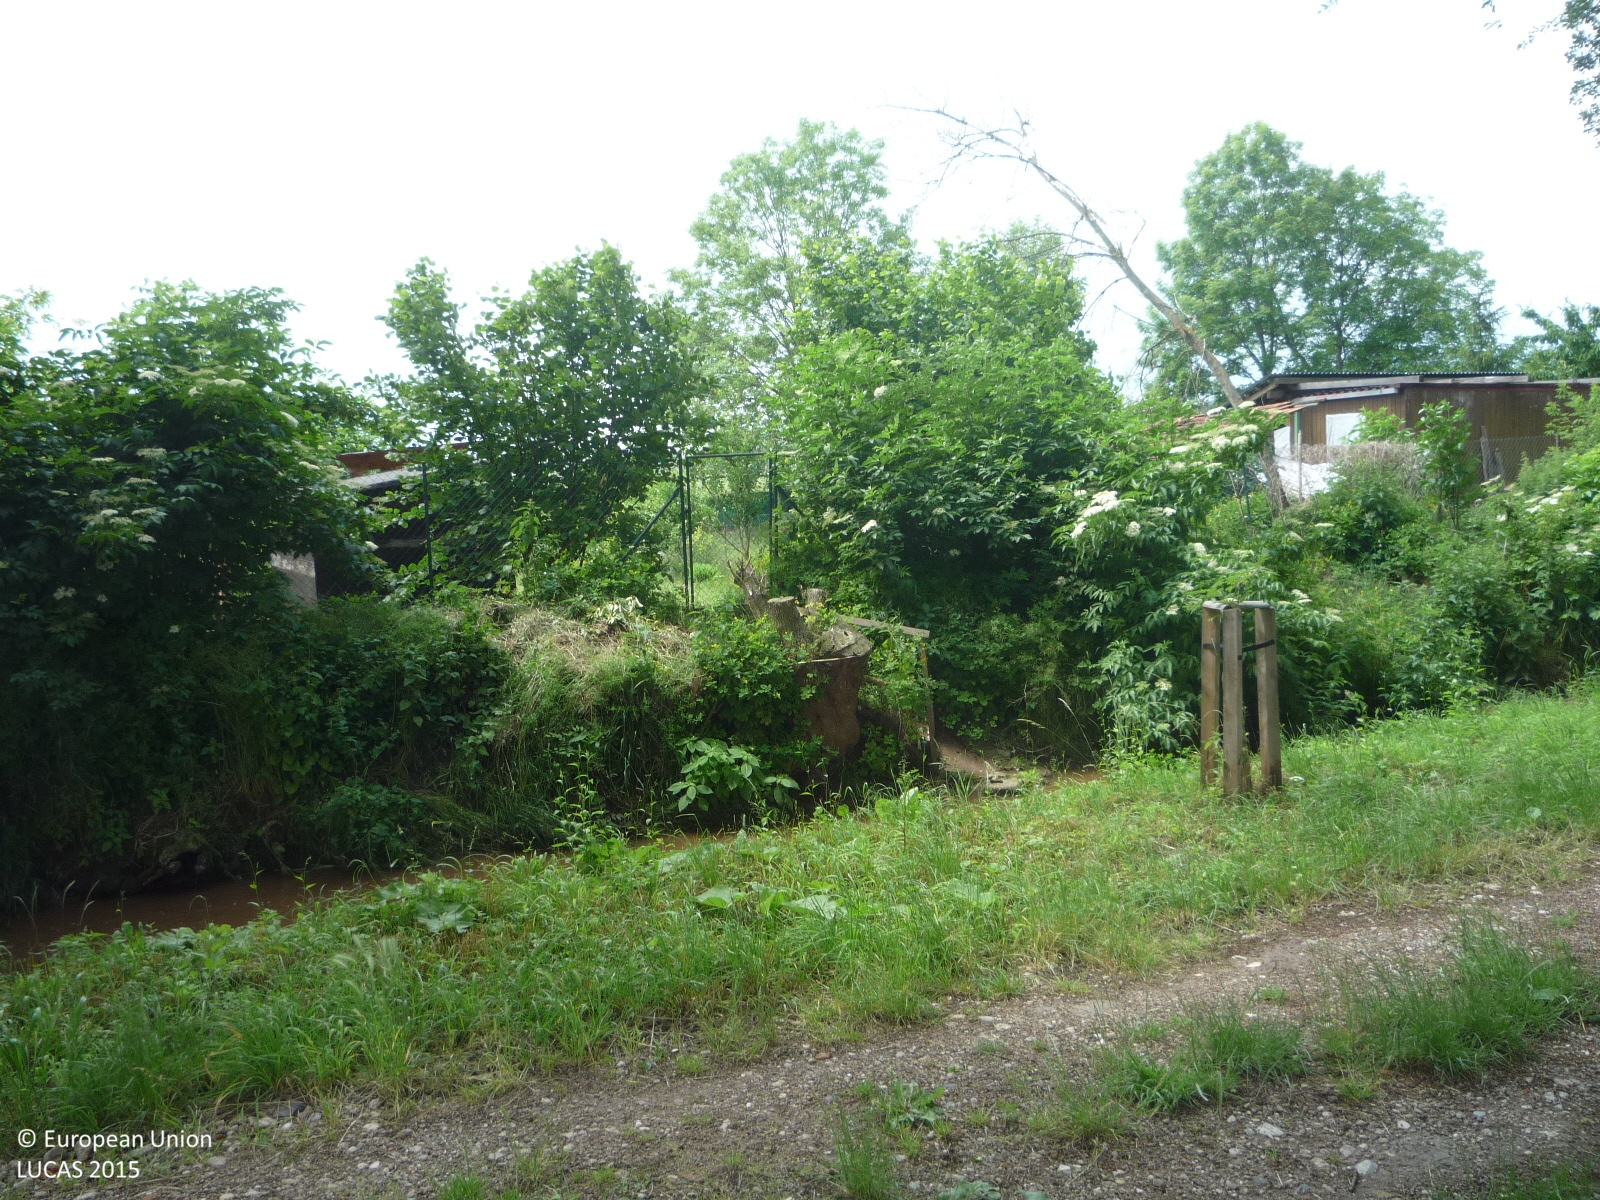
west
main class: Woodland
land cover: Broadleaved woodland
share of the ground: > 75 %
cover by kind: broadleaved forest trees 85 %, herbaceous plants 15 %
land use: Forestry
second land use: Amenities, museums, leisure
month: June
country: CZ
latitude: 50.3707
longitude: 13.8673
